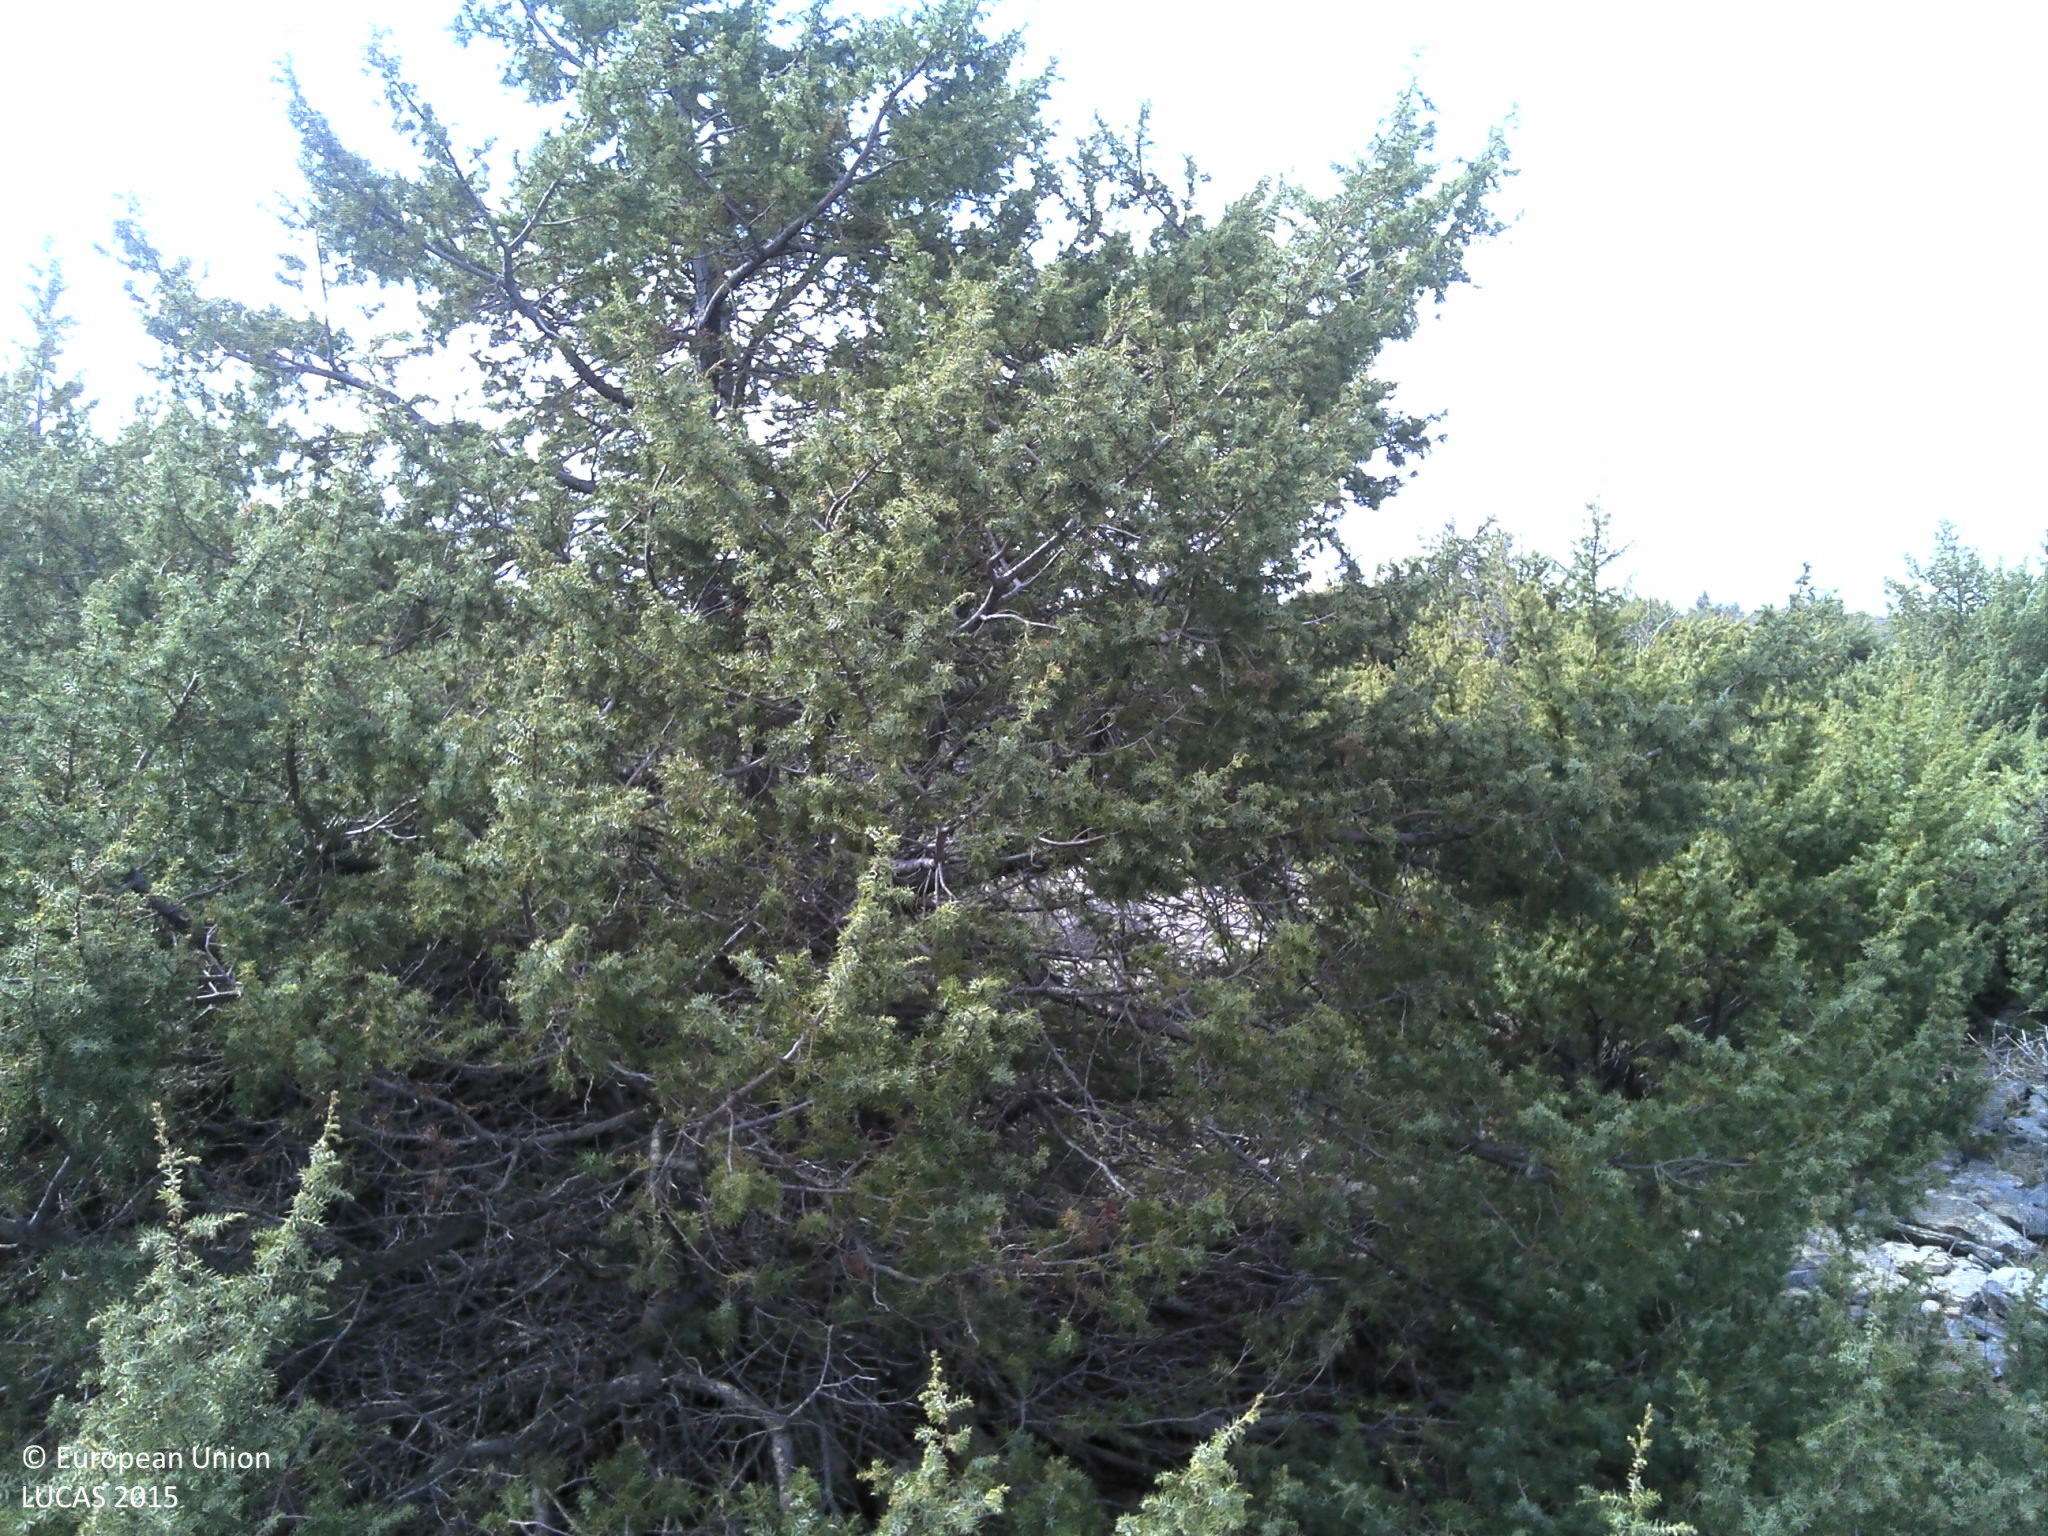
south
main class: Shrubland
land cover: Shrubland with sparse tree cover
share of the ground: 25 - 50 %
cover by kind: shrubs 30 %, unconsolidated bare surface 30 %, consolidated bare surface 10 %, broadleaved forest trees 5 %
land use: Semi-natural and natural areas not in use
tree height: < 5 m
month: March
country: HR
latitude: 43.9678
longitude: 15.8625
